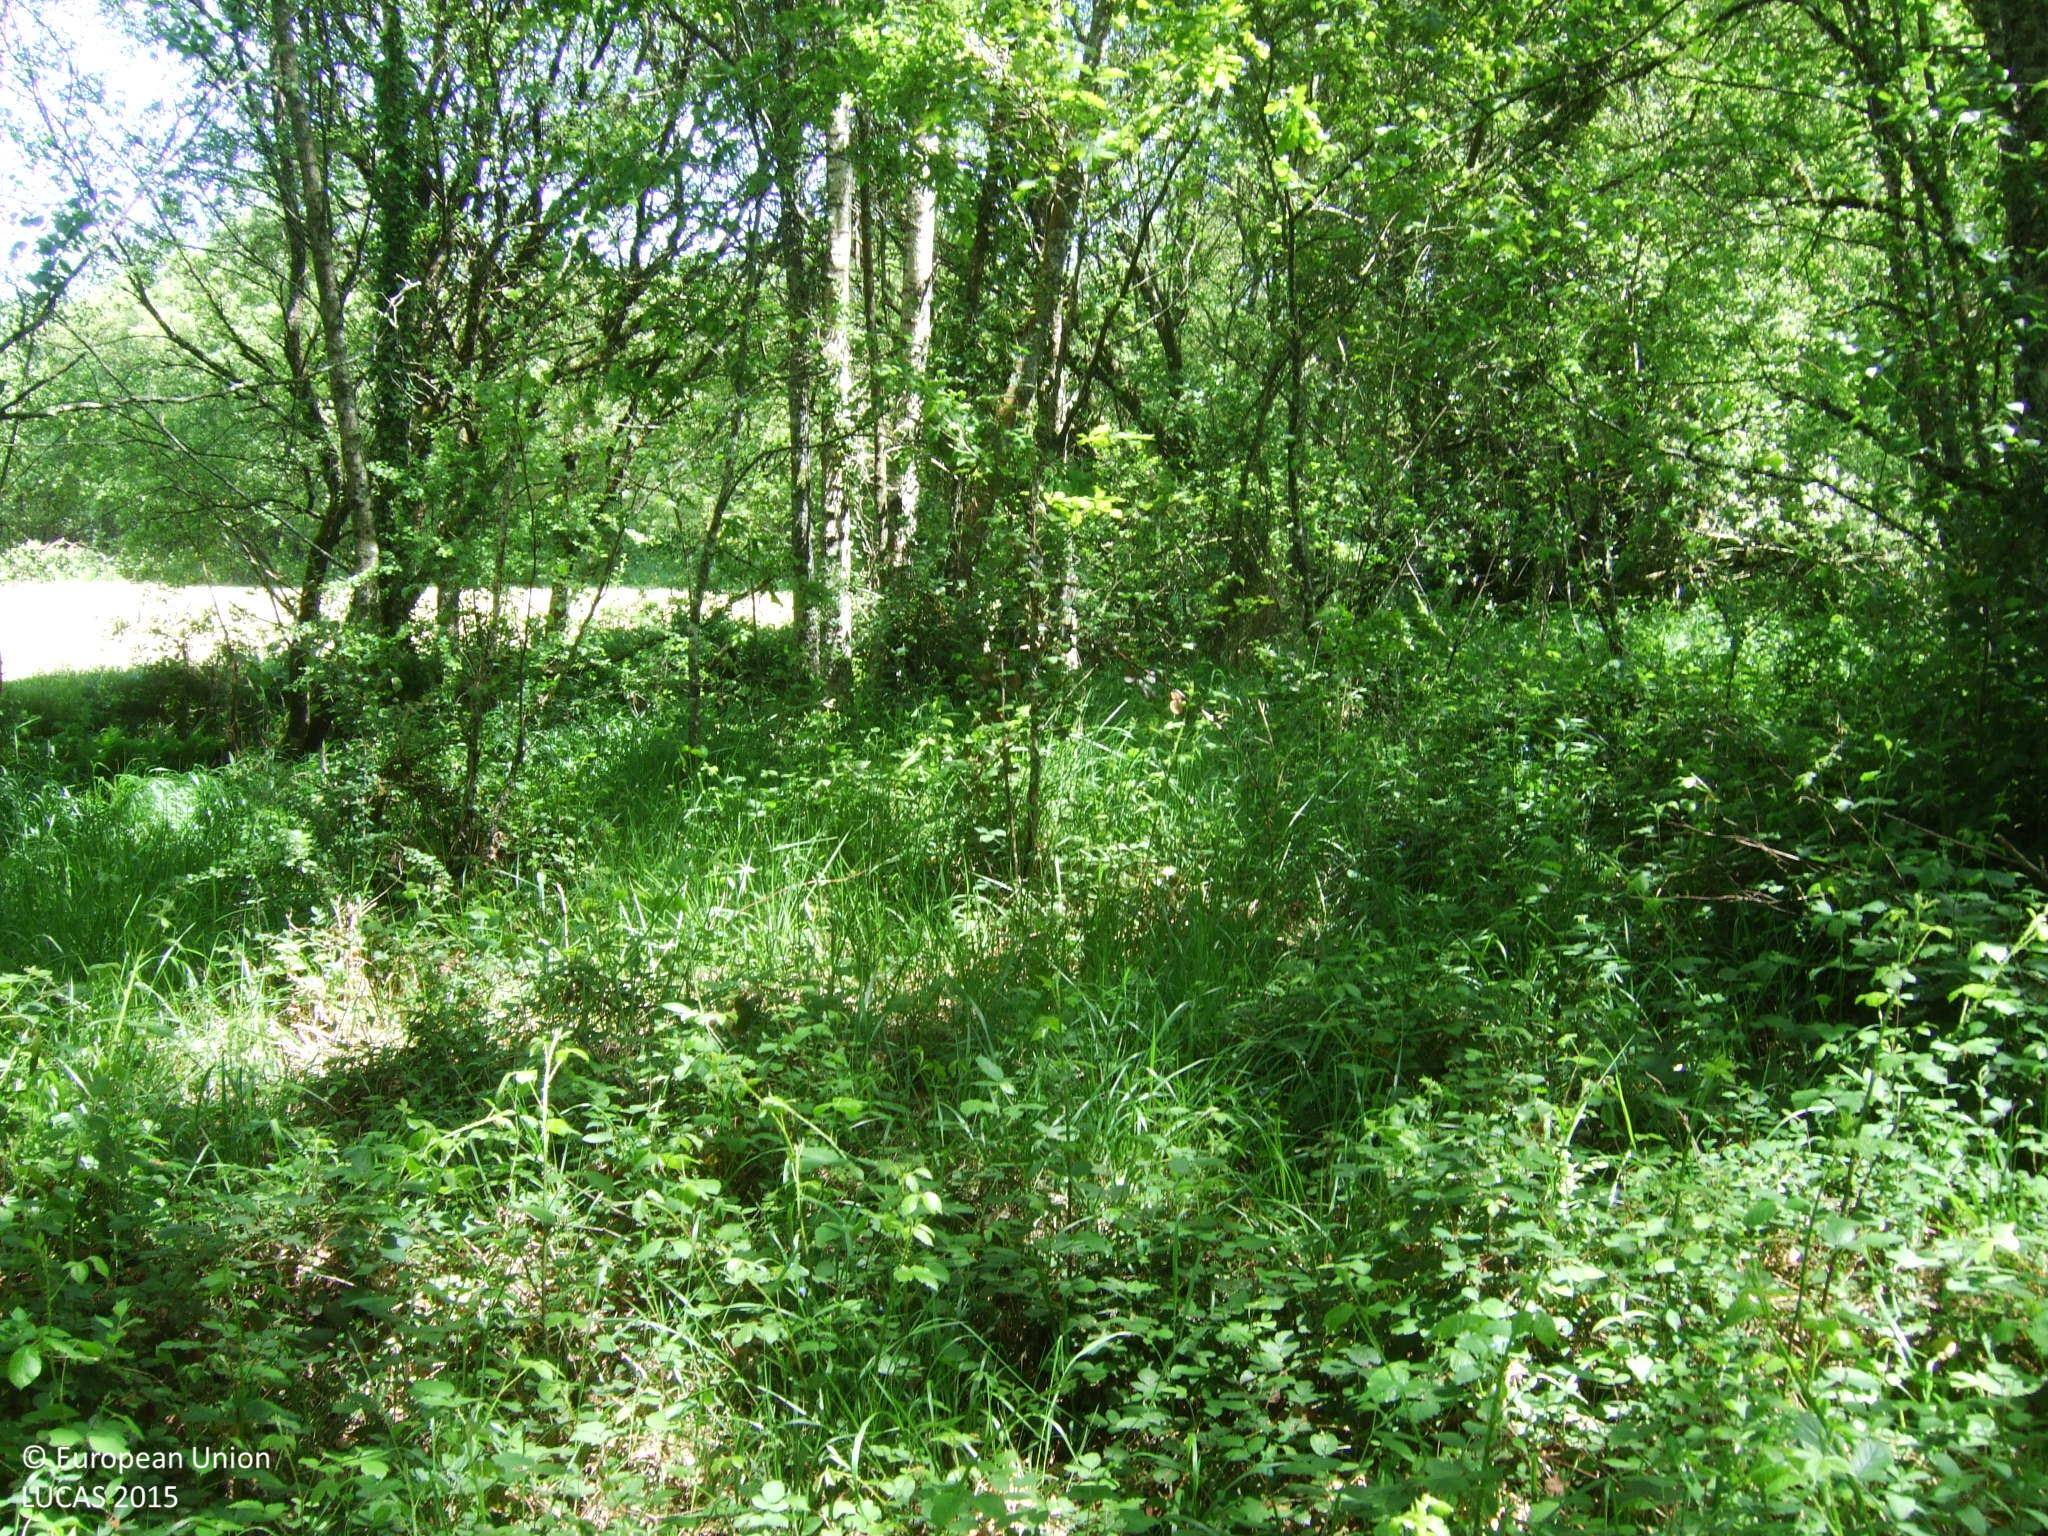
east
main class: Woodland
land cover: Broadleaved woodland
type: acidophilous oak and oak-birch forest
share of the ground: > 75 %
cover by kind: broadleaved forest trees 85 %, shrubs 15 %
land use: Semi-natural and natural areas not in use
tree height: > 5 m
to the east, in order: Broadleaved woodland; Inland fresh running water; Groves; Grassland without tree/shrub cover; Groves; Shruby margins; Grassland without tree/shrub cover; Groves; Tracks; Shruby margins; Grassland without tree/shrub cover; Groves; Rivers and streams; Groves; Grassland without tree/shrub cover; Groves; Grassland without tree/shrub cover
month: May
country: ES
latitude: 43.2984
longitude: -7.7756
